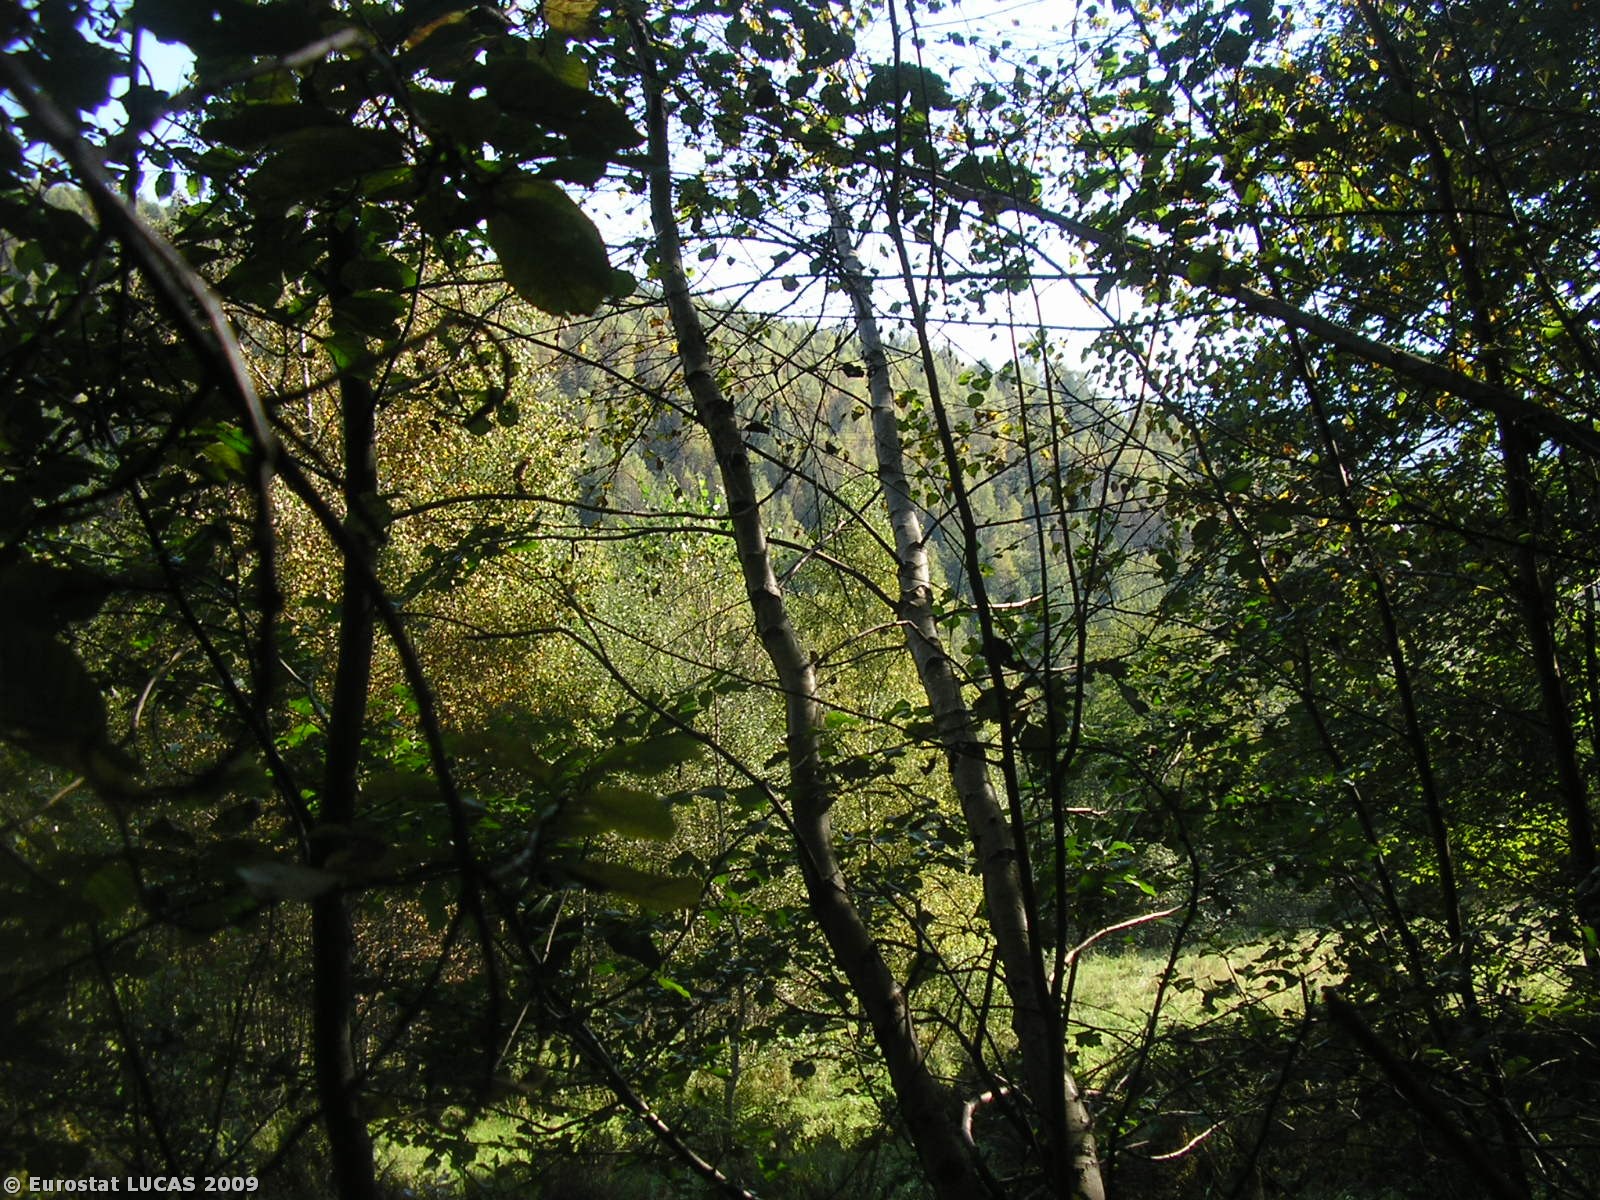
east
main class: Woodland
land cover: Broadleaved woodland
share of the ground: > 75 %
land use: Unused
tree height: < 5 m
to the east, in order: Broadleaved woodland; Grassland with sparse tree/shrub cover; Electric lines; Grassland with sparse tree/shrub cover; Broadleaved woodland; Grassland with sparse tree/shrub cover; Paved roads, cycling and walking lanes; Grass margins; Broadleaved woodland
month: September
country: PL
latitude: 49.6718
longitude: 19.5749
